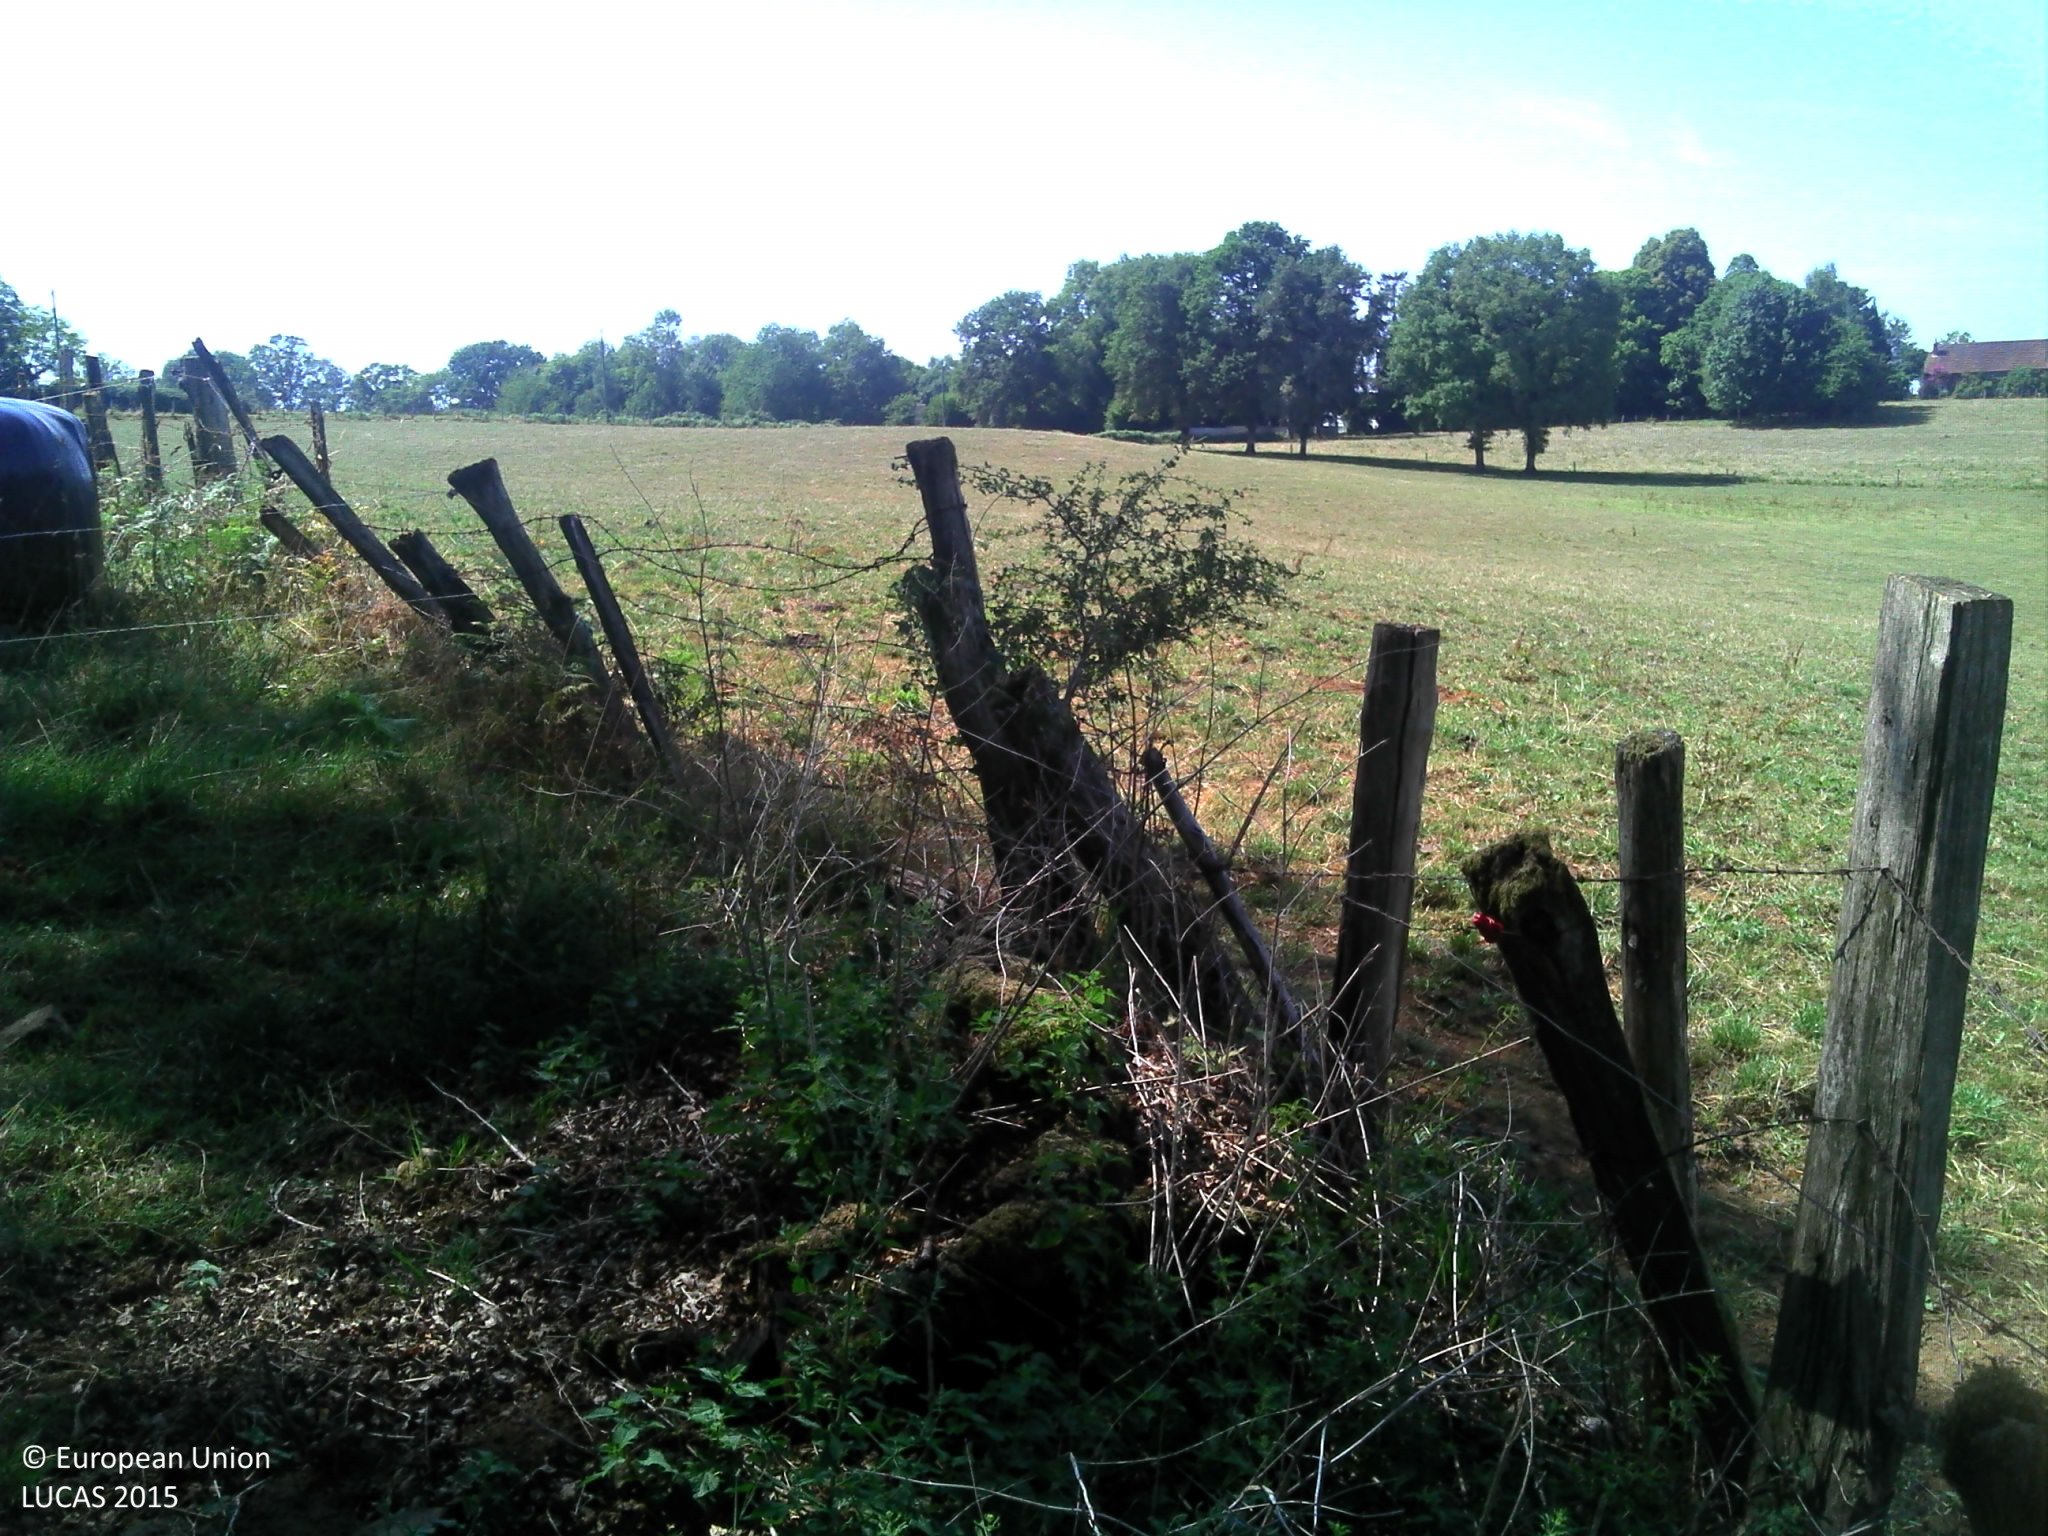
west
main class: Grassland
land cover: Grassland without tree/shrub cover
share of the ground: > 75 %
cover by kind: herbaceous plants 100 %
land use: Agriculture (excluding fallow land and kitchen gardens)
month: August
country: FR
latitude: 45.3750
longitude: 1.6823
